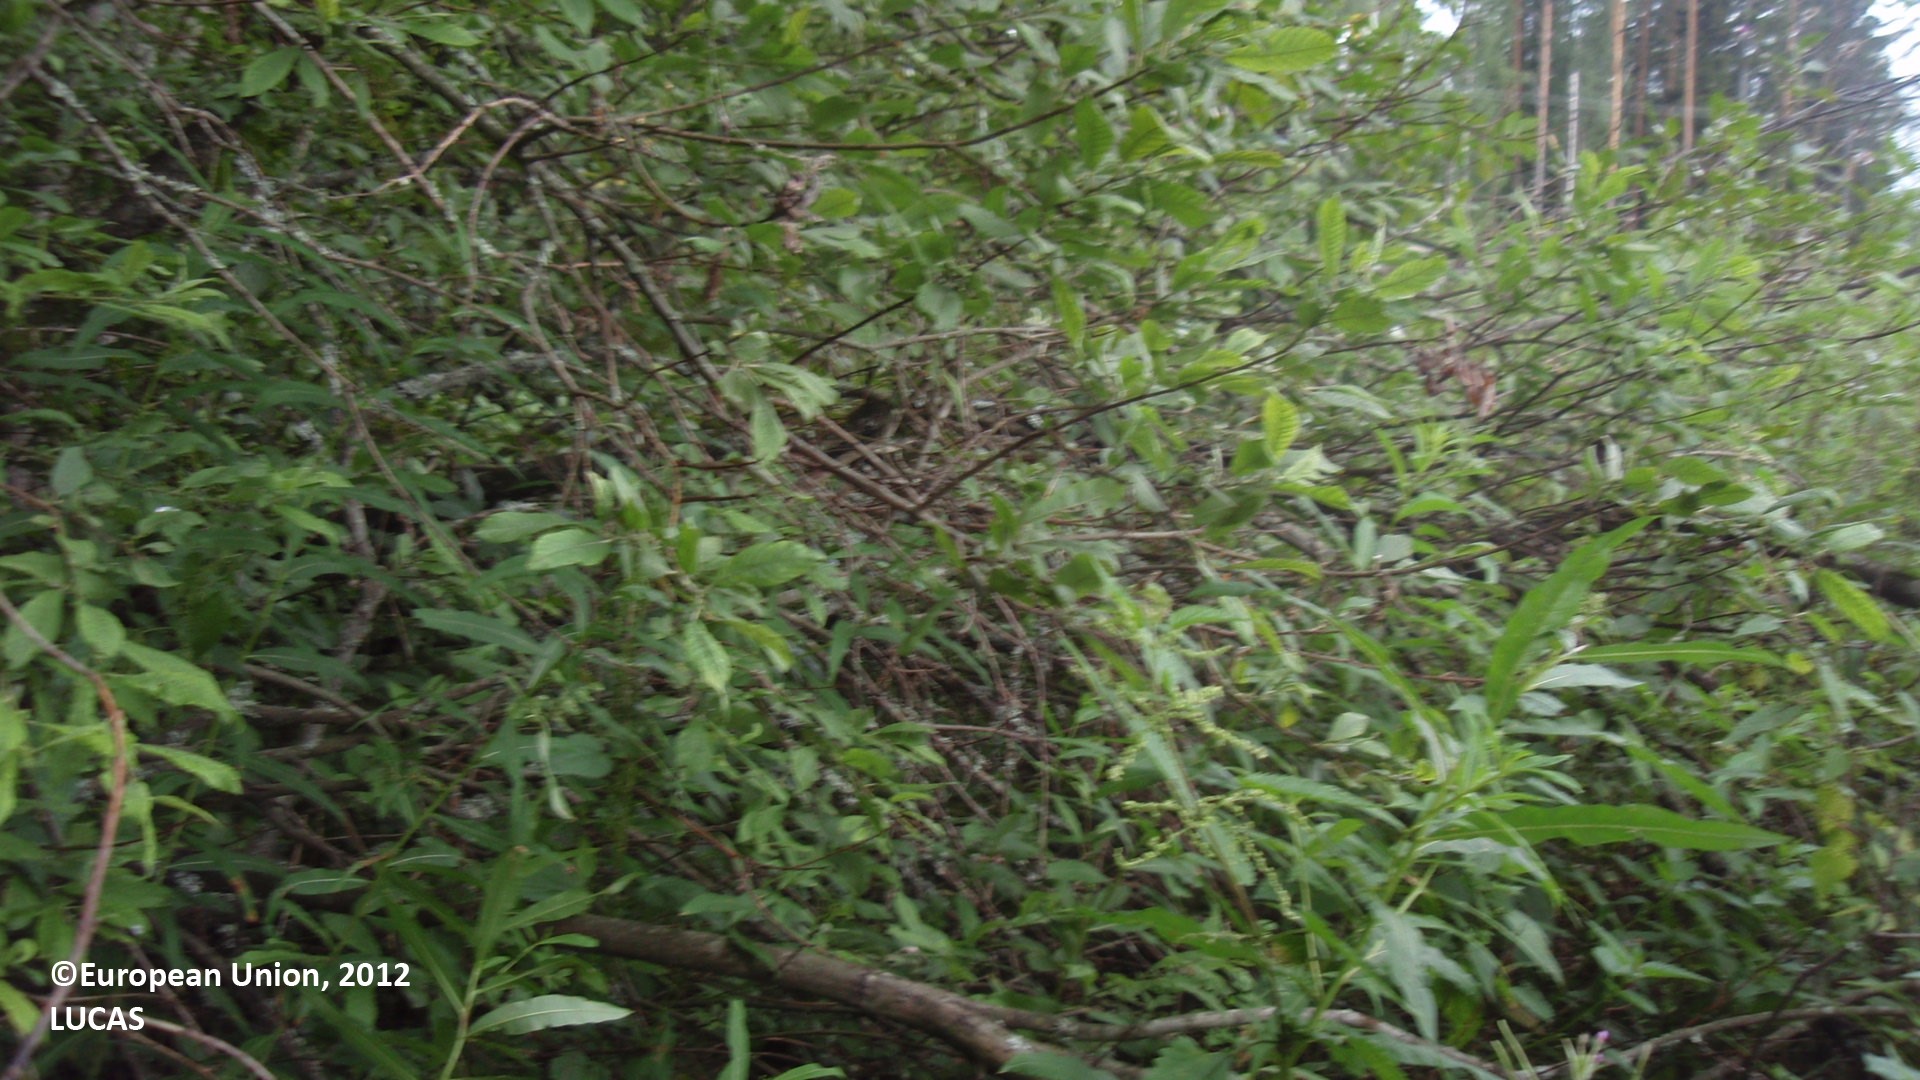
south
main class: Shrubland
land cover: Shrubland with sparse tree cover
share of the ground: > 75 %
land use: Abandoned areas
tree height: < 5 m
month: August
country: FI
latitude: 61.1717
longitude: 27.6041
